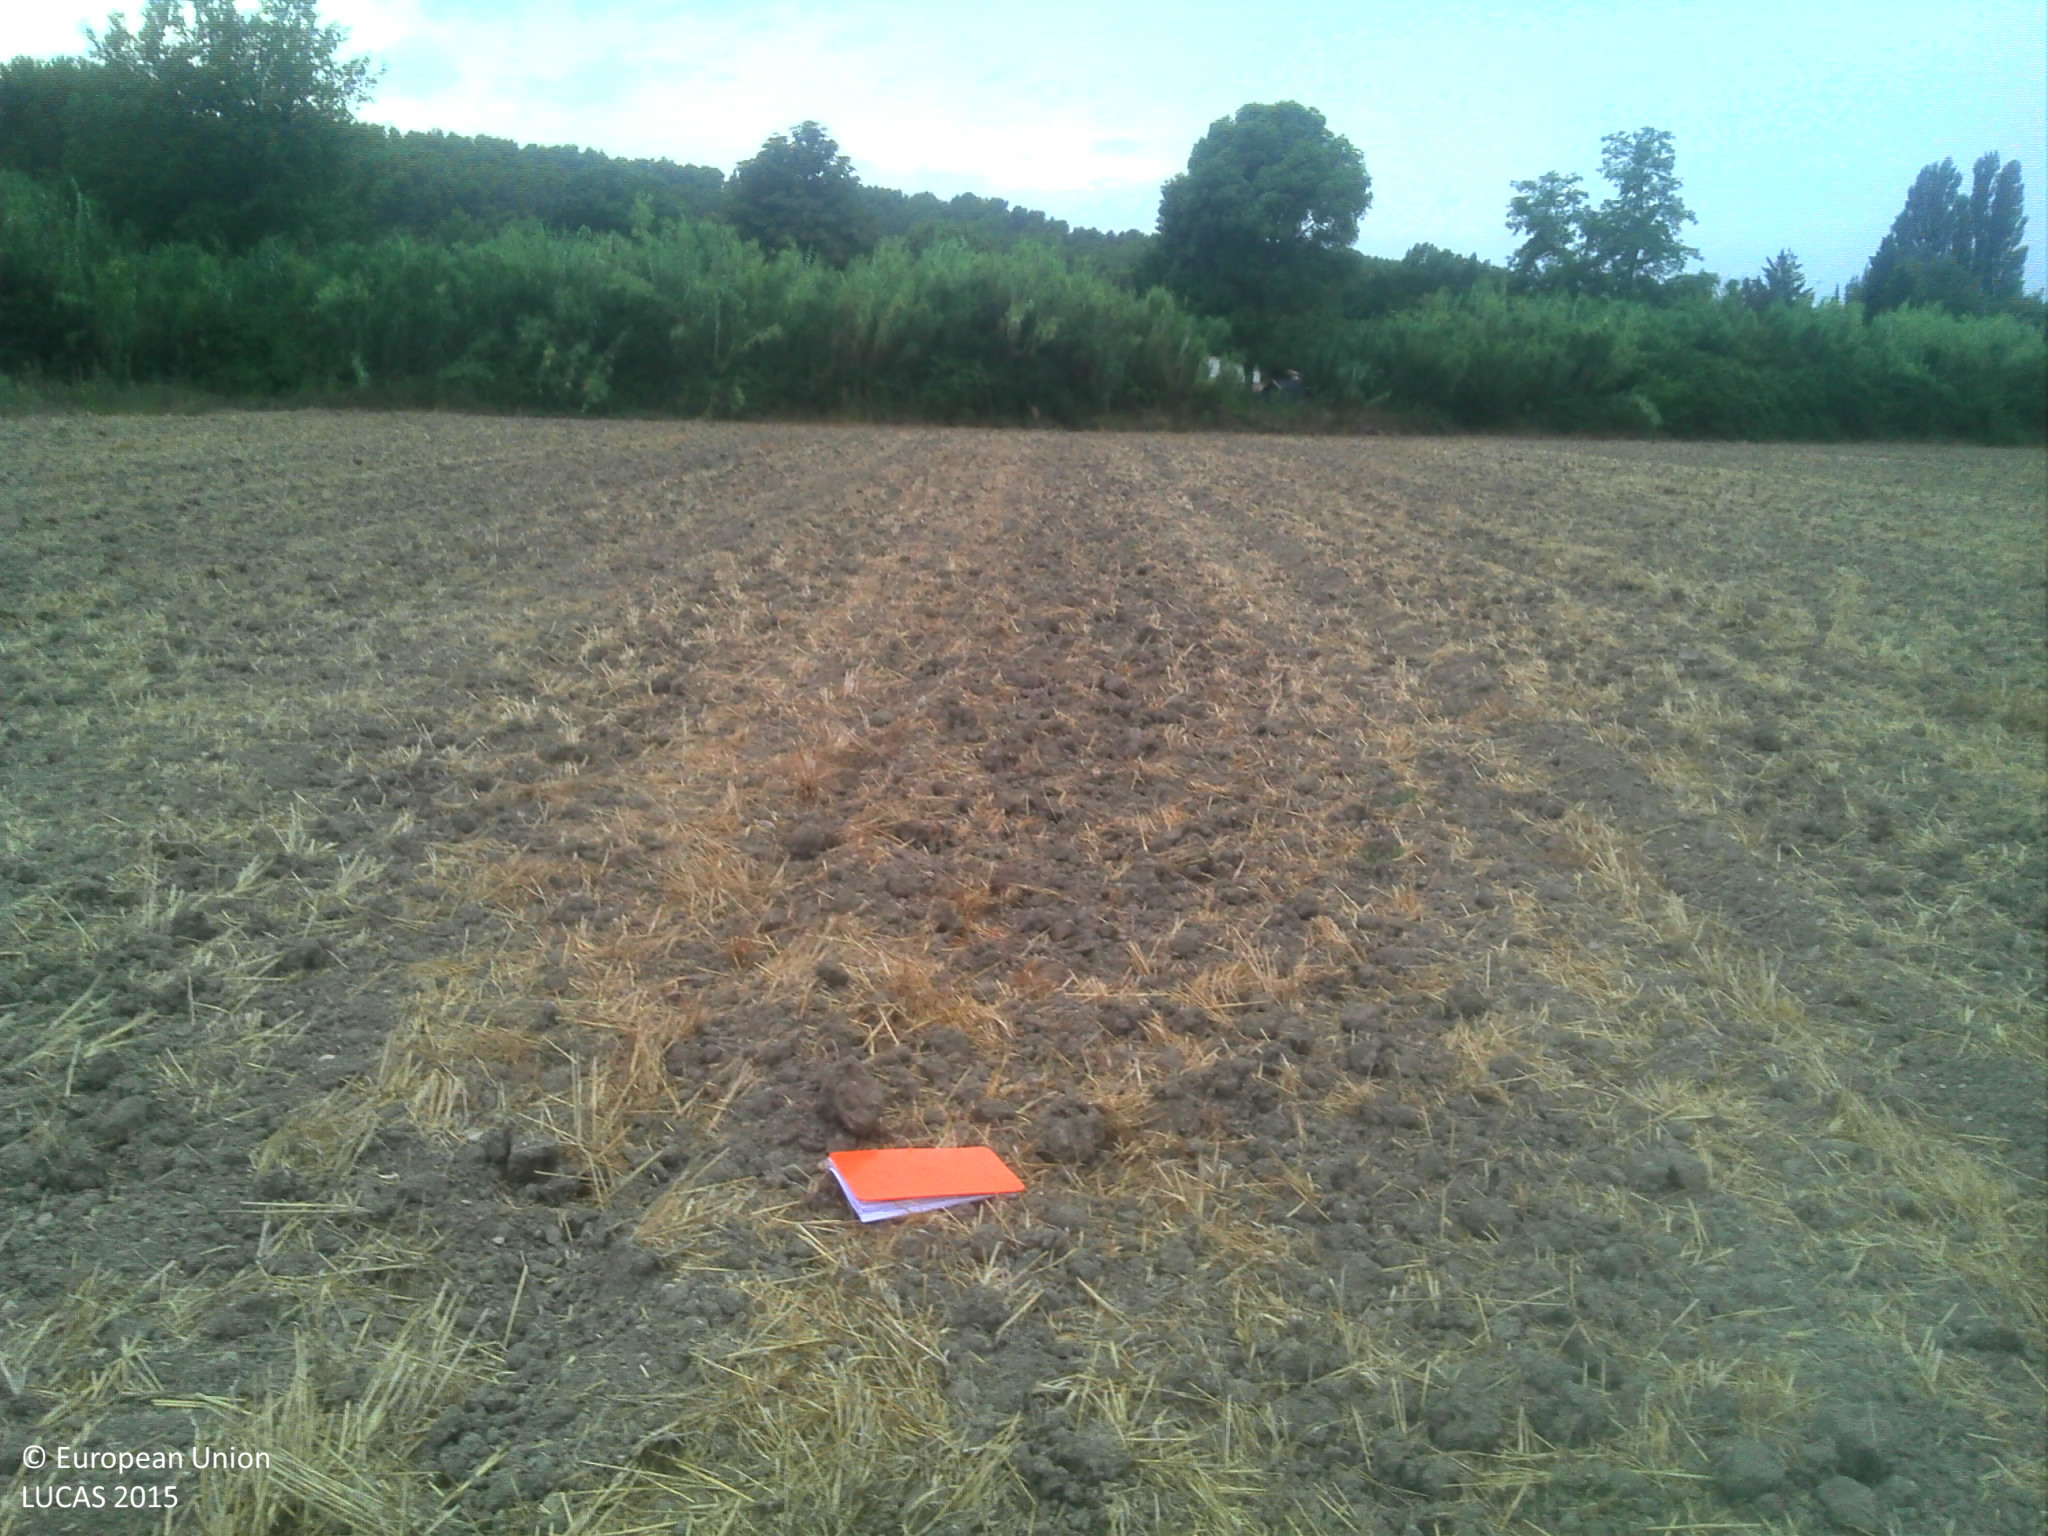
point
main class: Cropland
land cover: Durum wheat
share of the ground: 10 - 25 %
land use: Agriculture (excluding fallow land and kitchen gardens)
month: August
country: FR
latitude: 43.4525
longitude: 5.3758
